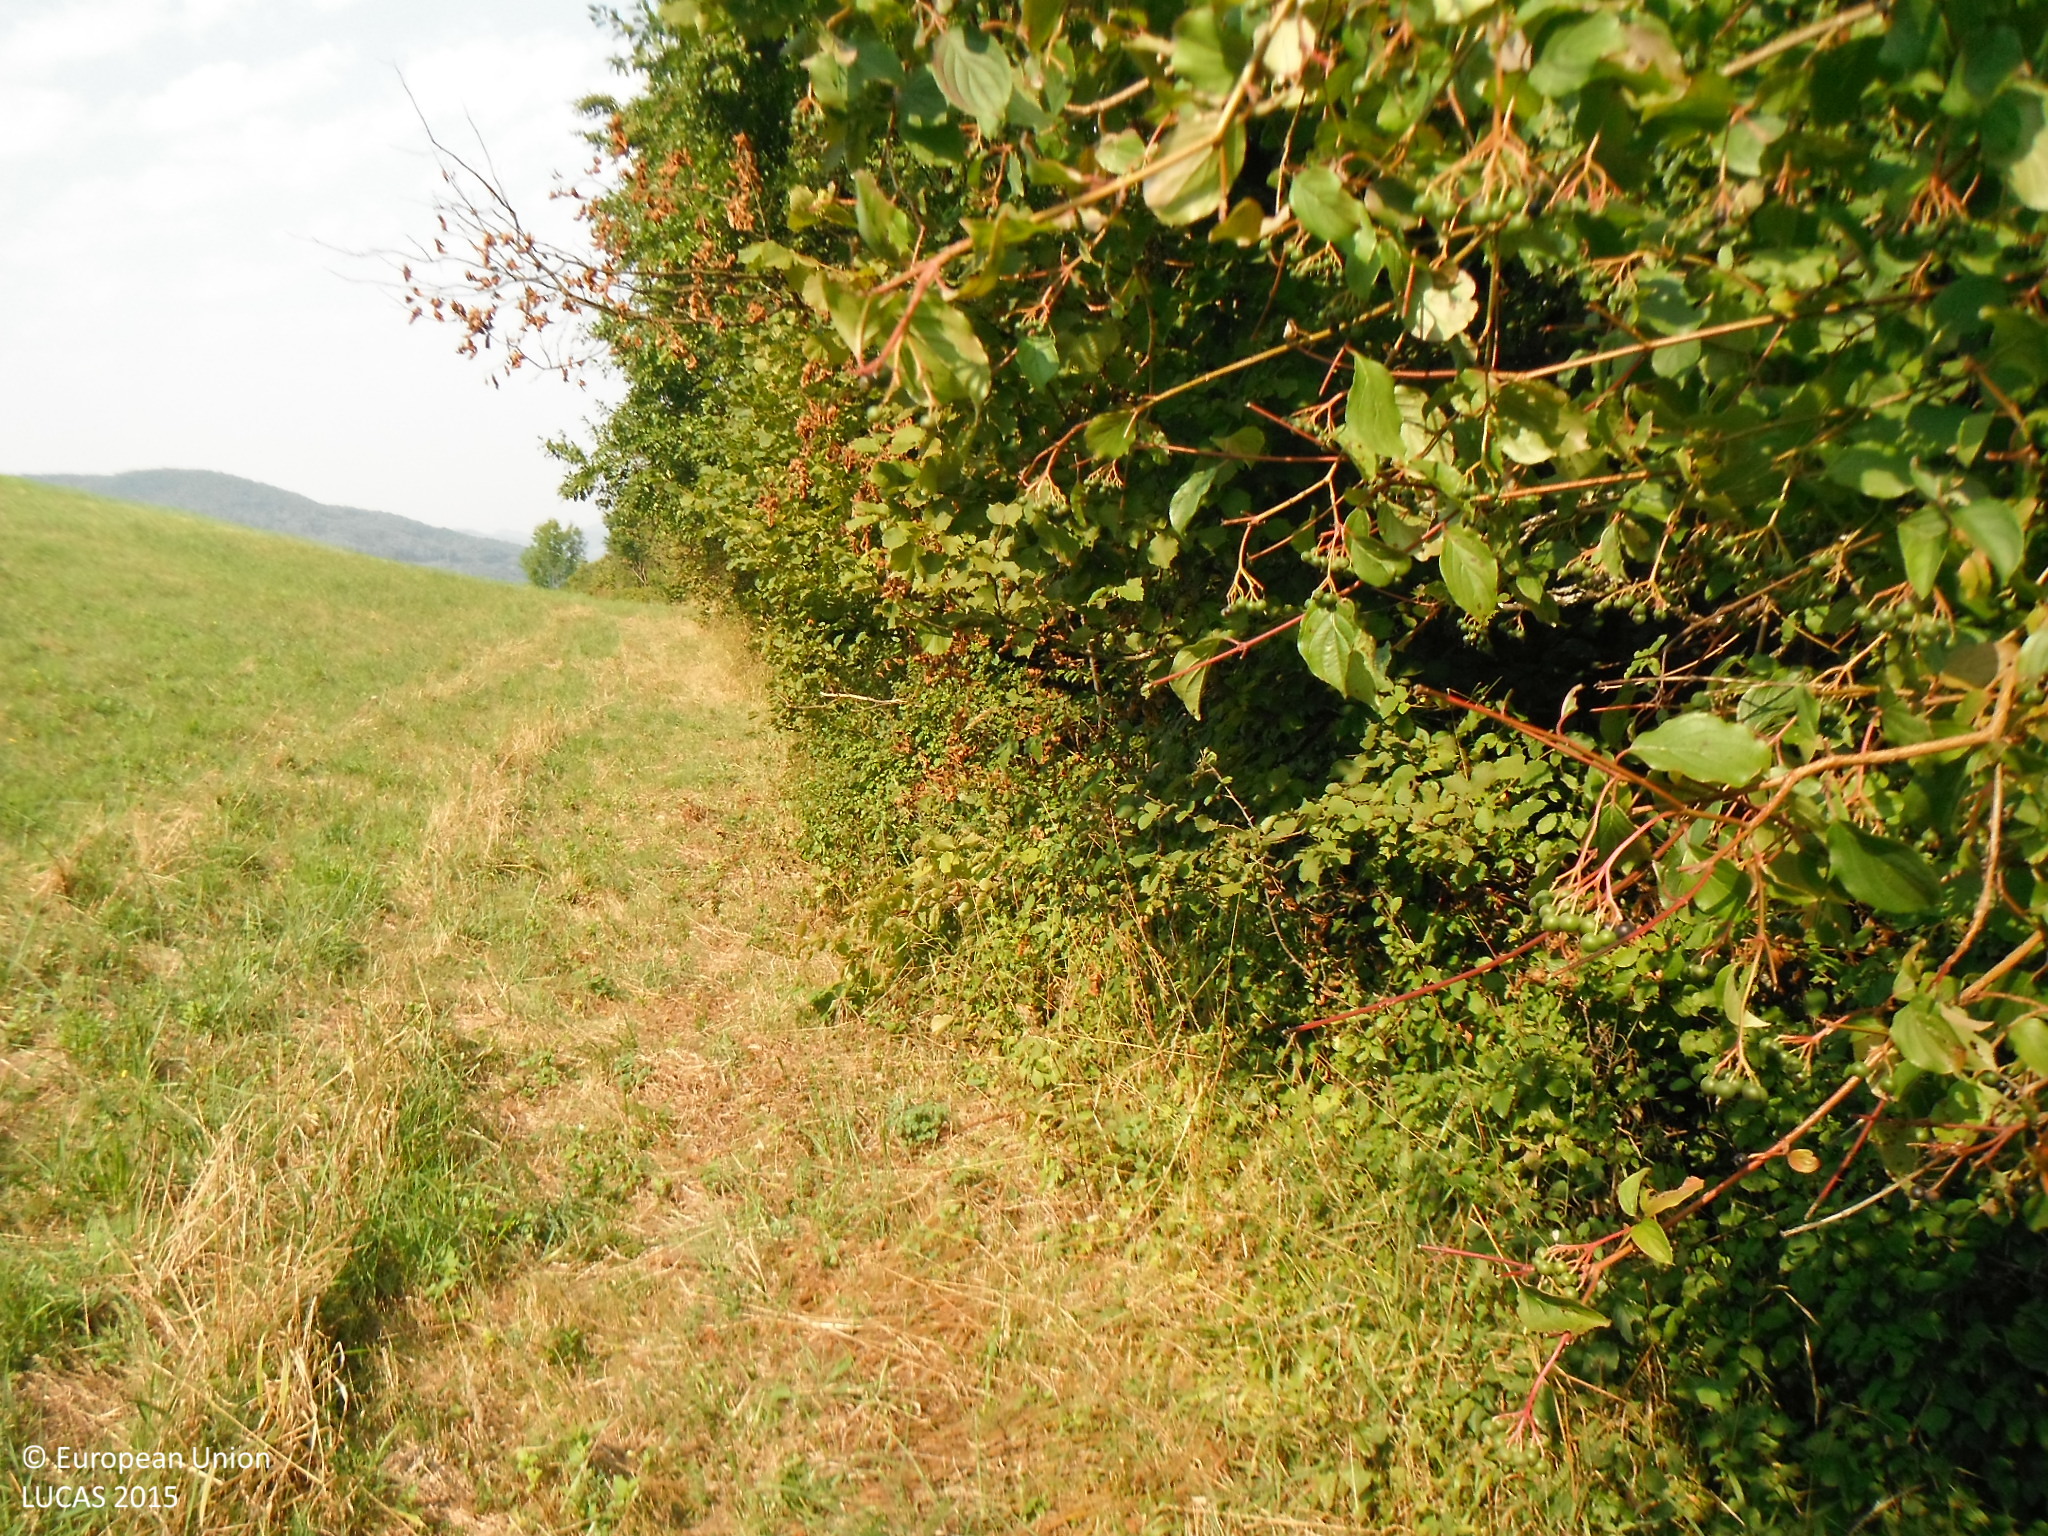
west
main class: Grassland
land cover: Grassland without tree/shrub cover
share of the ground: > 75 %
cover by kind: herbaceous plants 100 %
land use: Agriculture (excluding fallow land and kitchen gardens)
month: August
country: SK
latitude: 49.1332
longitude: 18.3913
